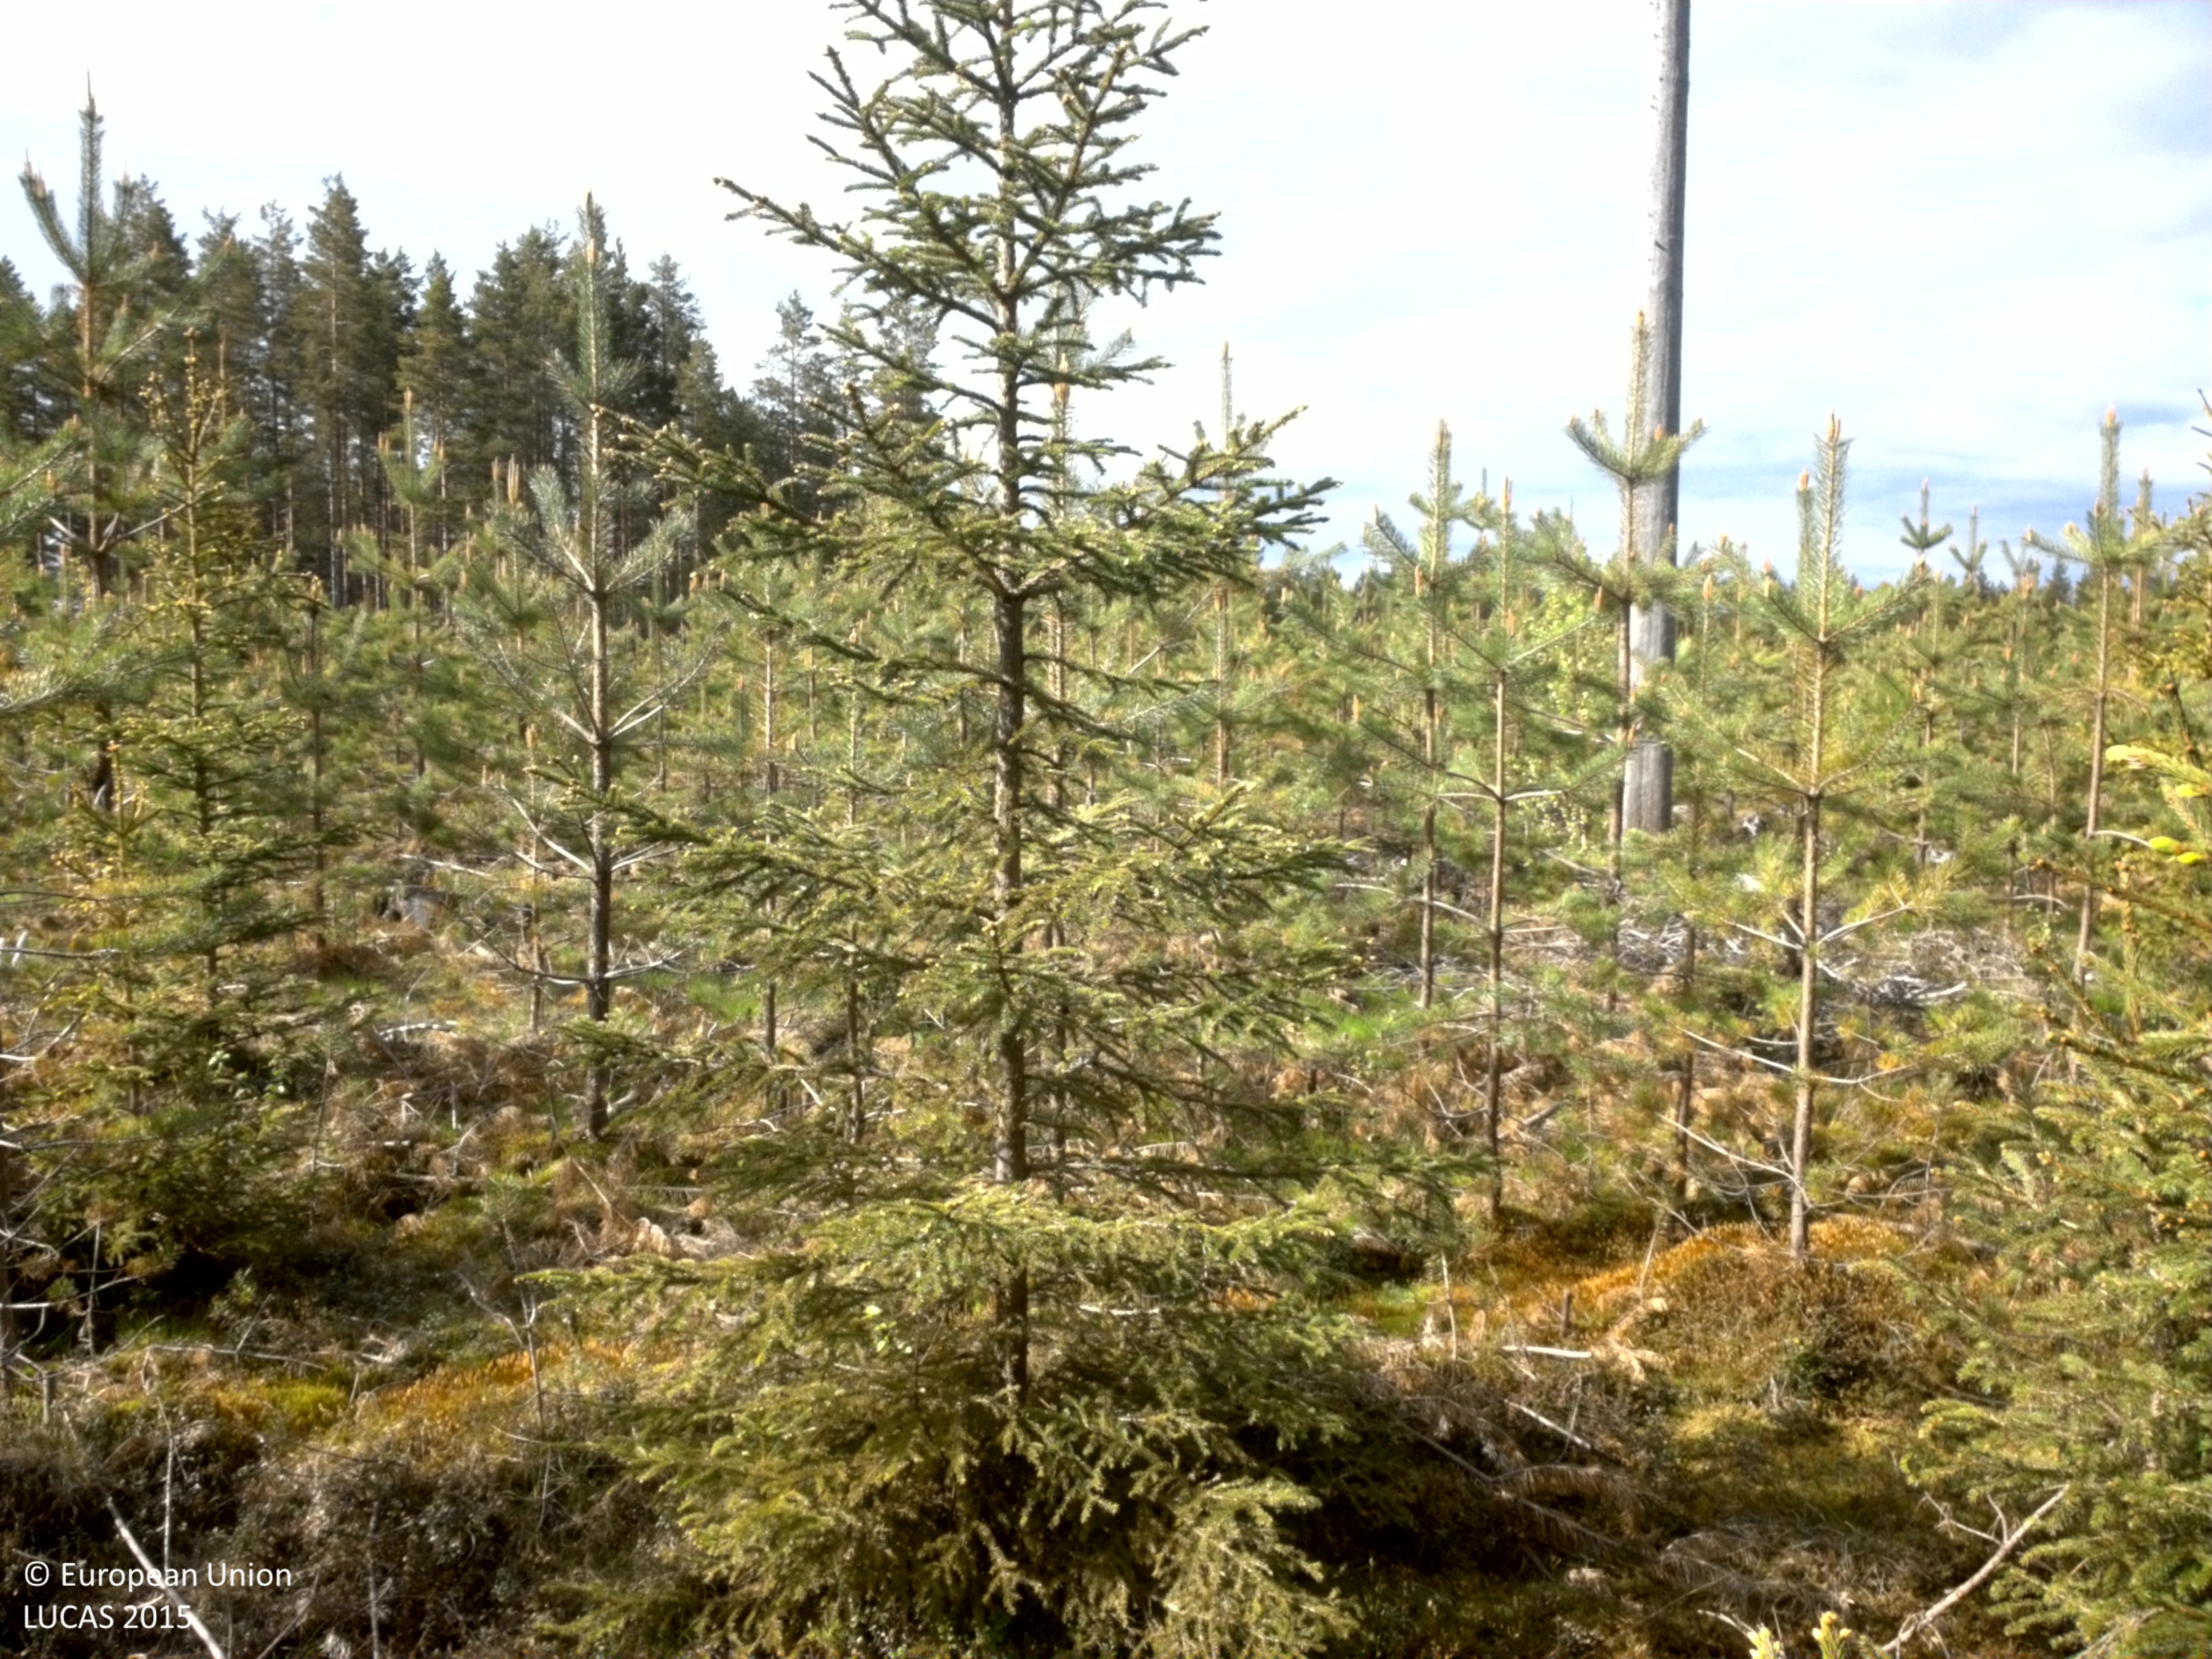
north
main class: Woodland
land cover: Other coniferous woodland
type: boreal forest
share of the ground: > 75 %
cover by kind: coniferous forest trees 90 %, shrubs 5 %, lichens and mosses 5 %
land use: Forestry
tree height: > 5 m
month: June
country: SE
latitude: 63.8950
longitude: 20.3499
